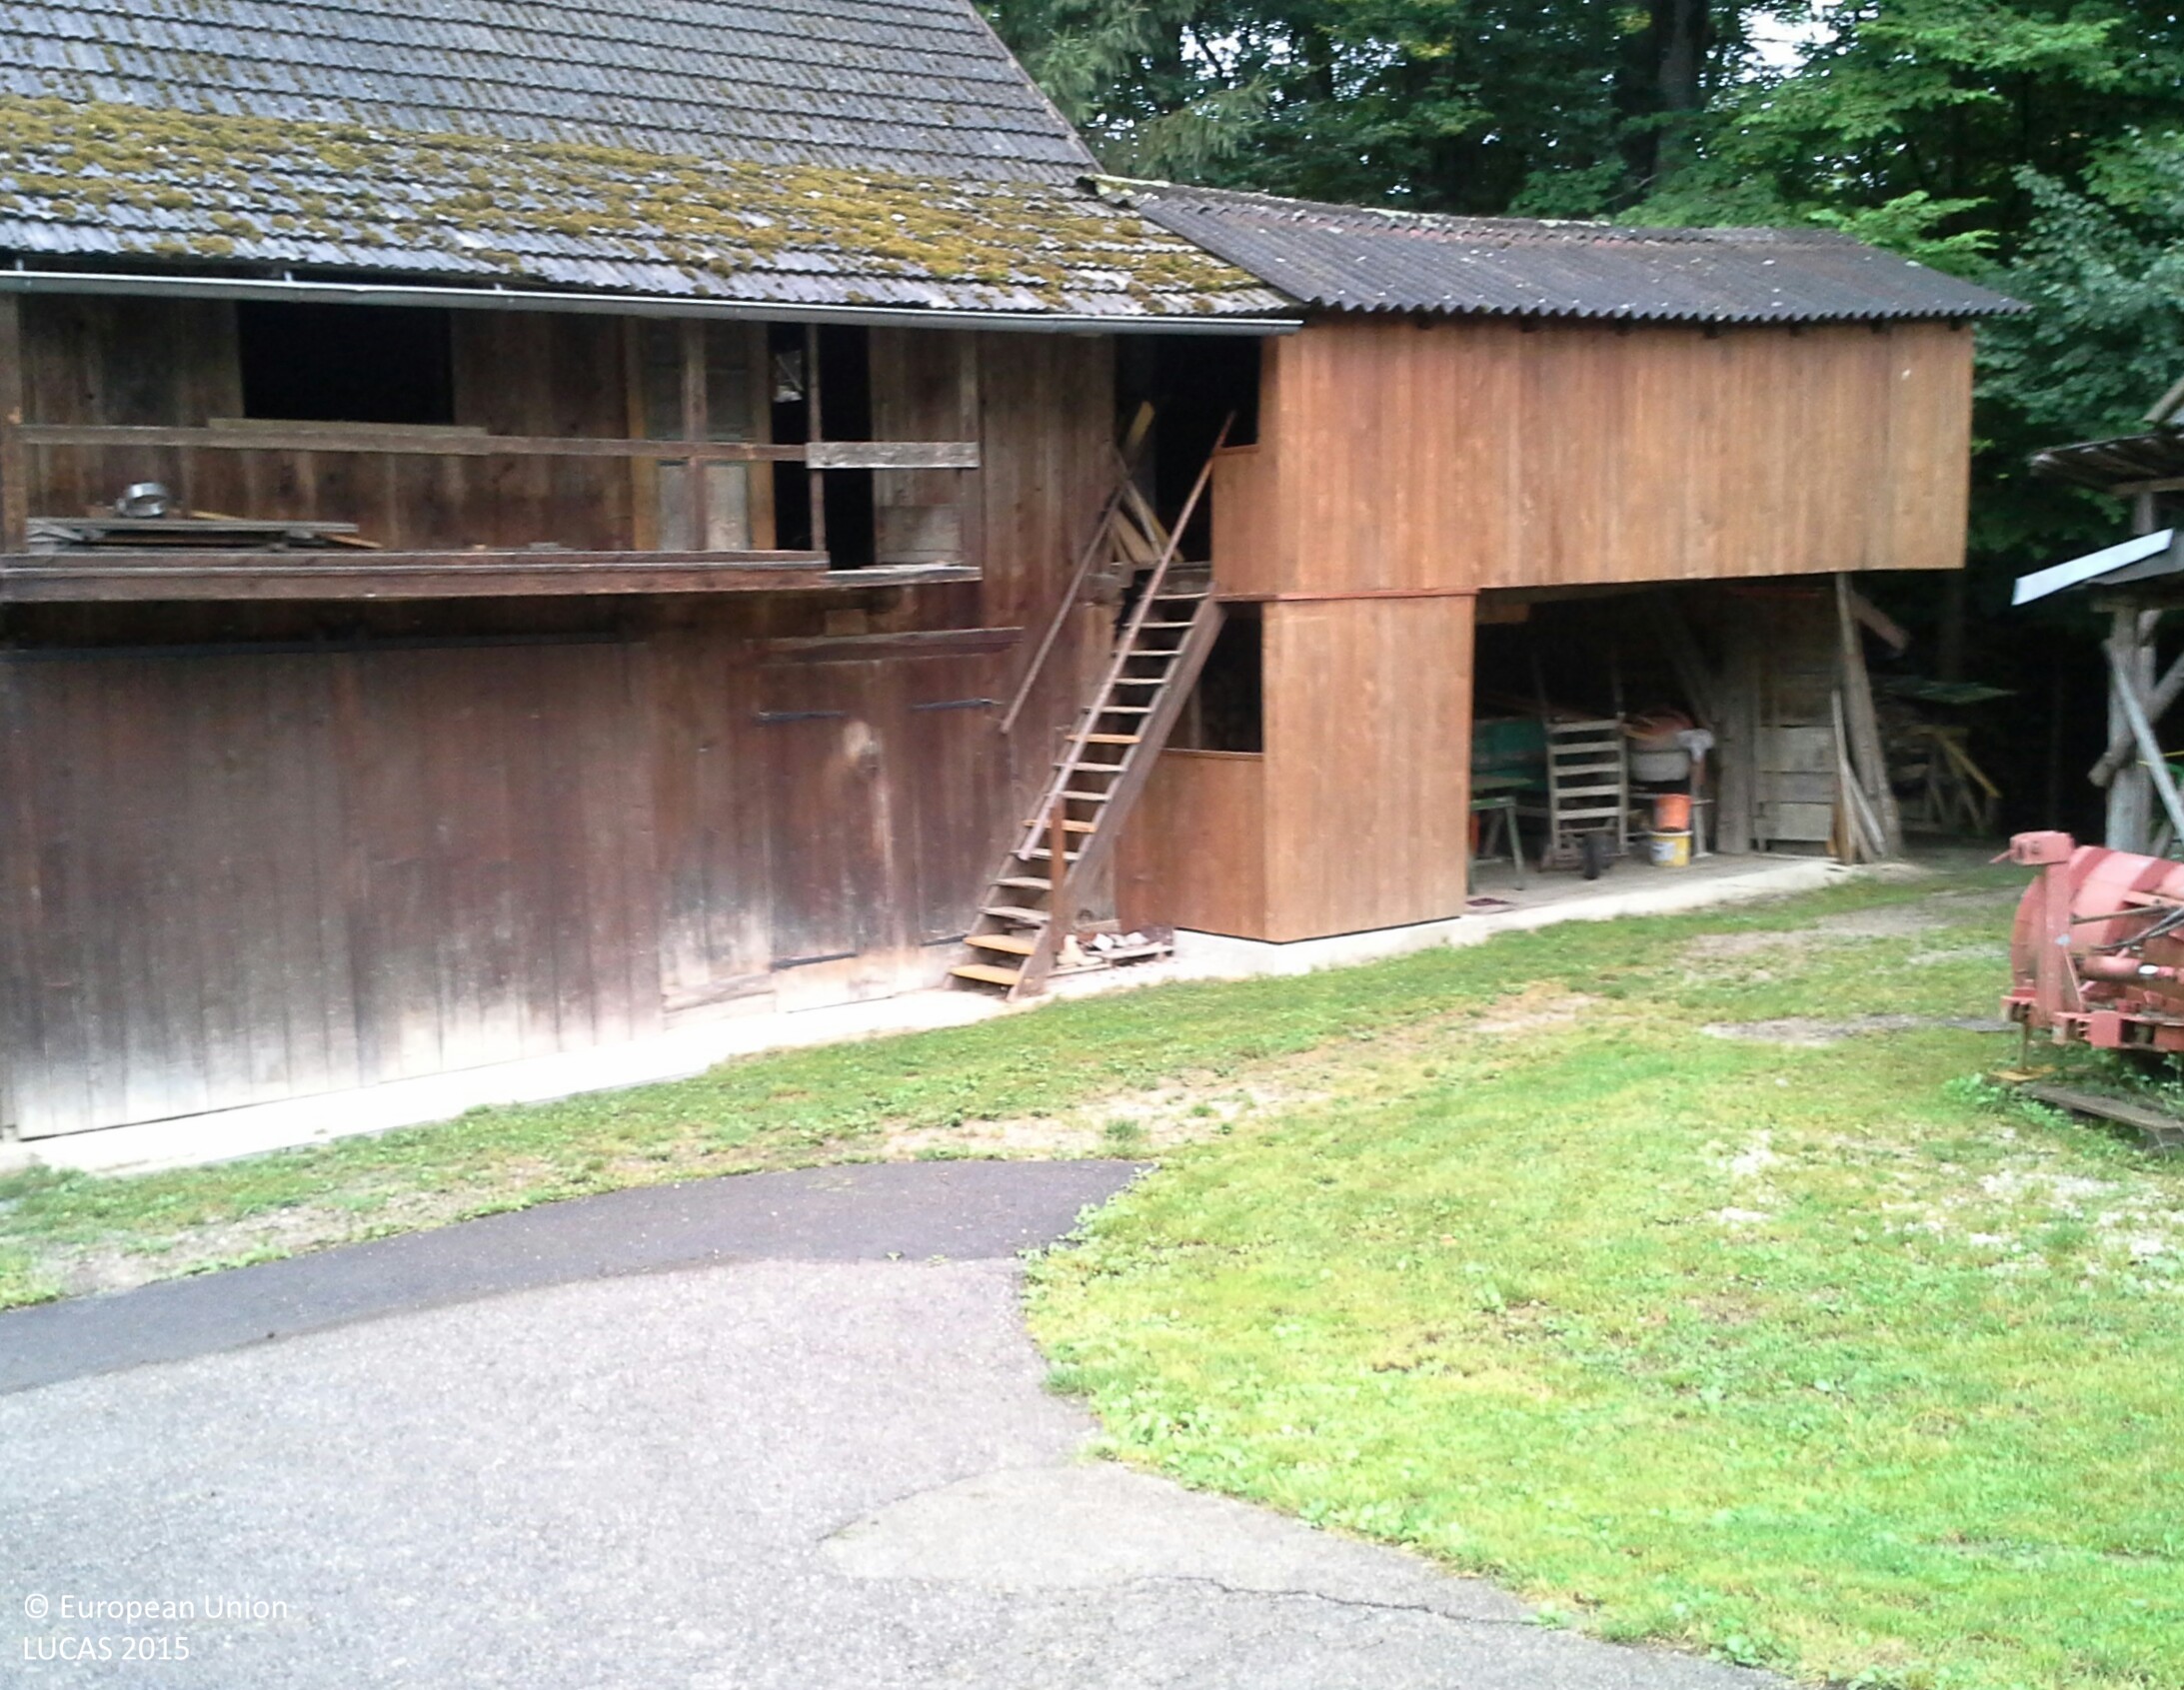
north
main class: Grassland
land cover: Grassland without tree/shrub cover
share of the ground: > 75 %
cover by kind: herbaceous plants 100 %
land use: Agriculture (excluding fallow land and kitchen gardens)
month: July
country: AT
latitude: 48.0271
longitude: 14.8415
